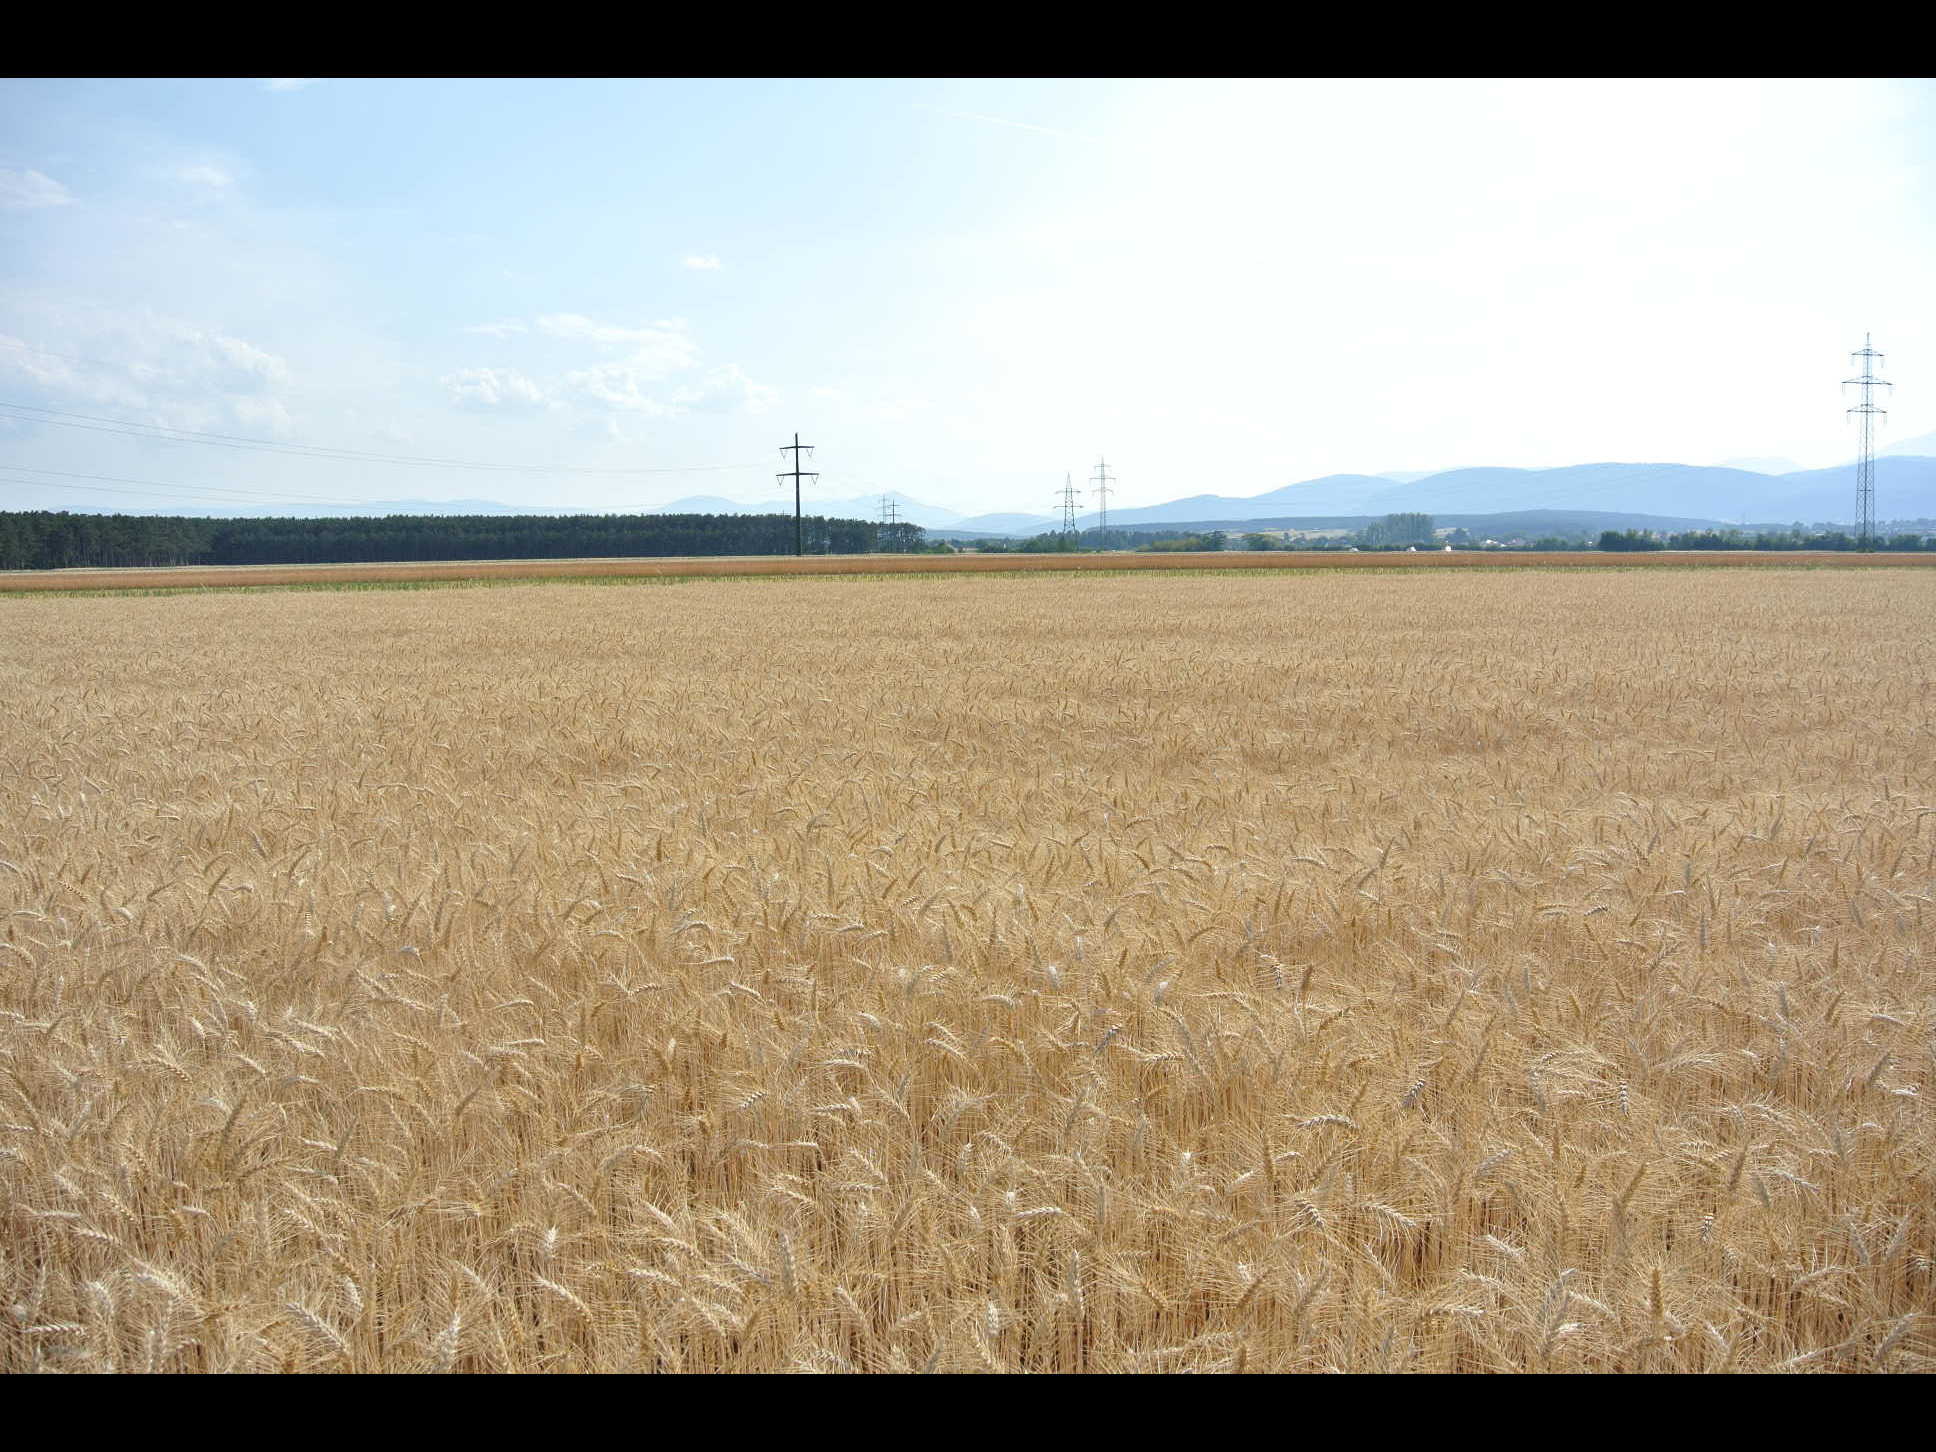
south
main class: Cropland
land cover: Common wheat
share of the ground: > 75 %
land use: Agriculture (excluding fallow land and kitchen gardens)
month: July
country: AT
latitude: 47.7823
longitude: 16.1294
